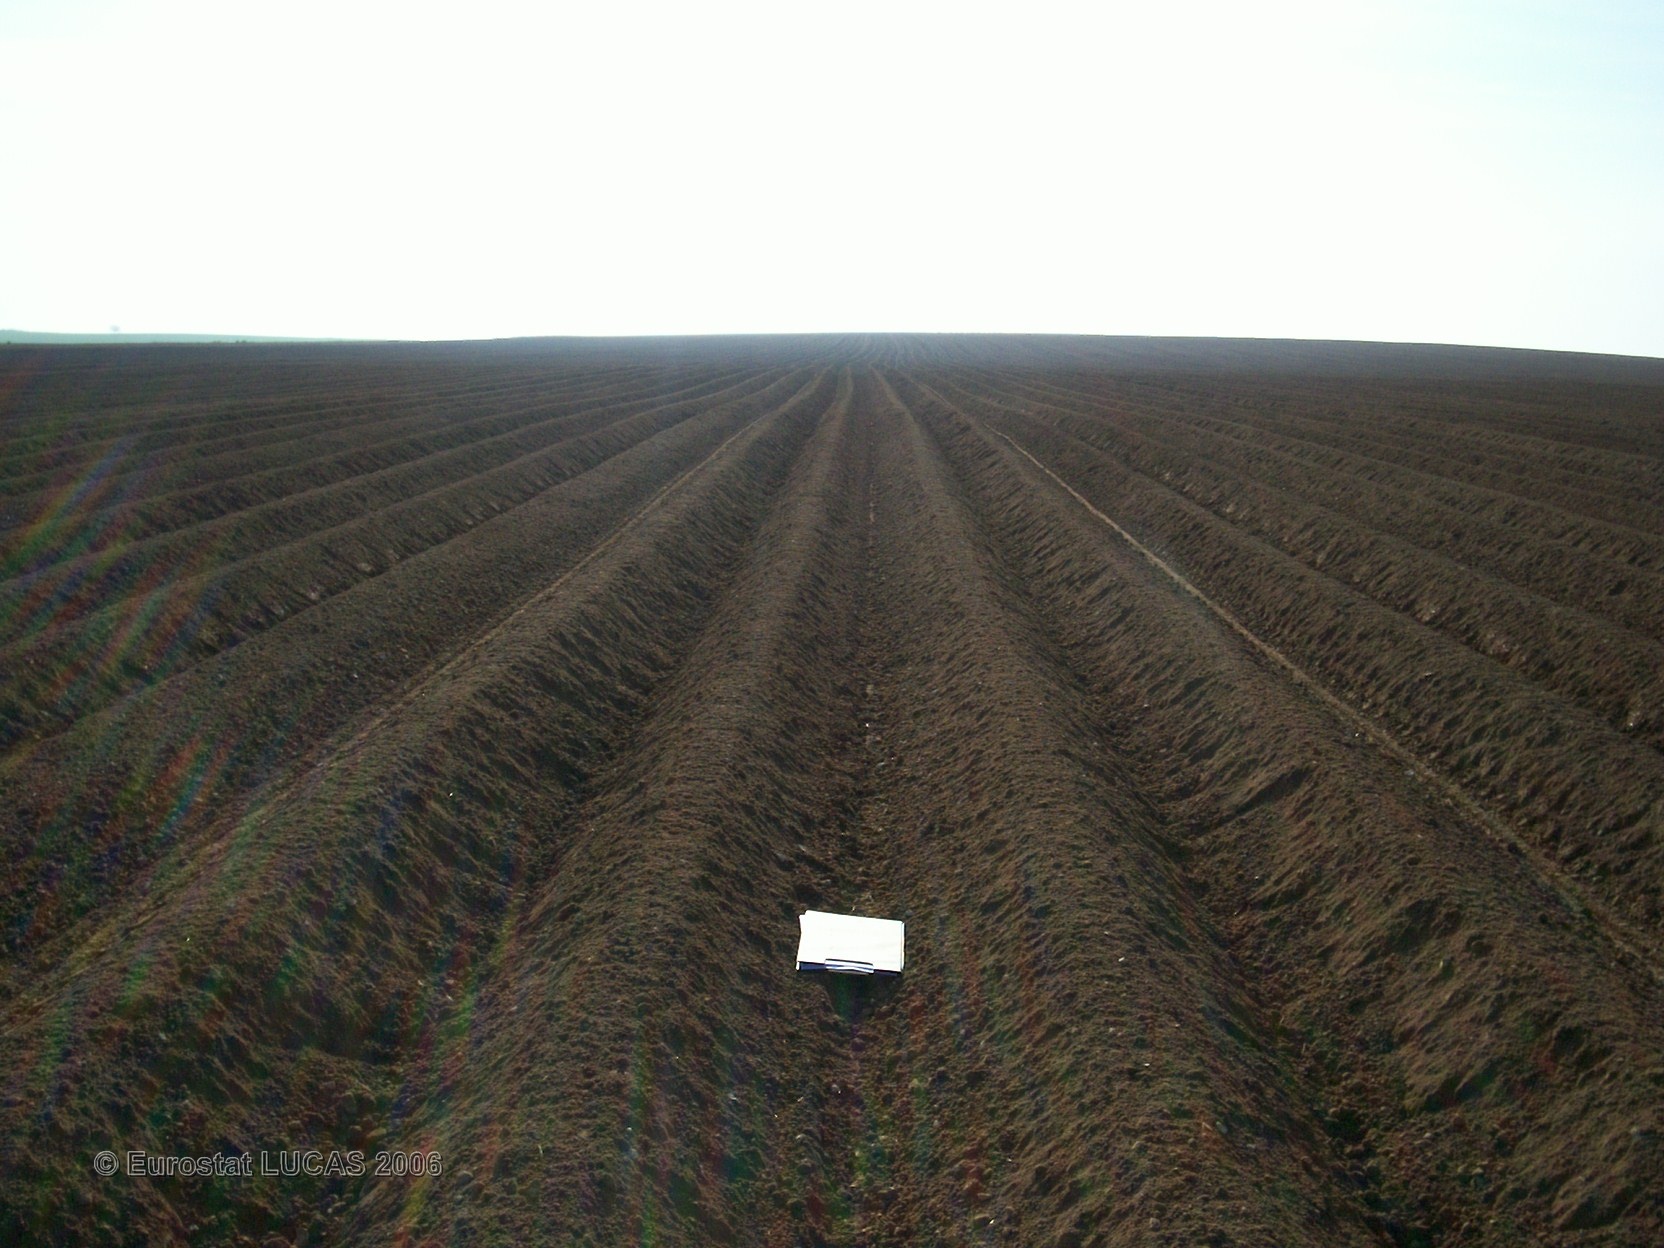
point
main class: Cropland
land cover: Potatoes
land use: Agriculture (excluding fallow land and kitchen gardens)
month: April
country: FR
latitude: 48.4620
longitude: 4.4389
